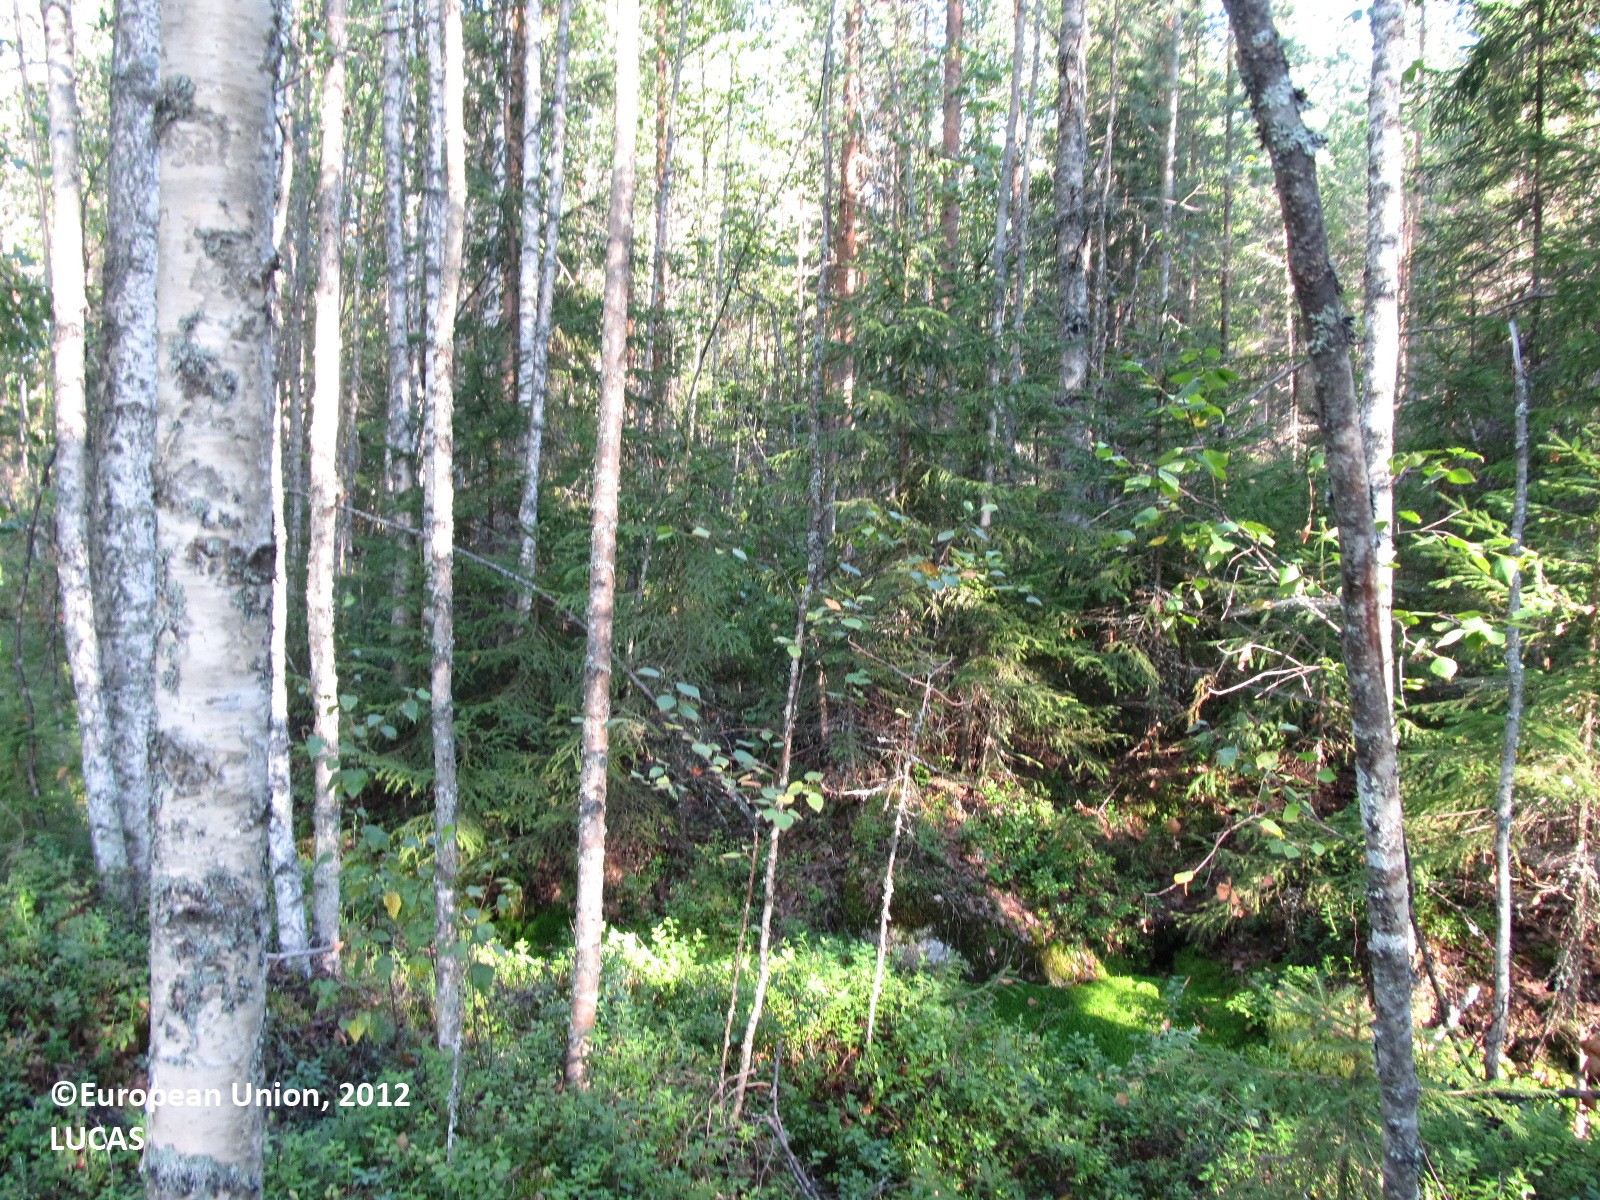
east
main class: Woodland
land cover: Pine dominated mixed woodland
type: boreal forest
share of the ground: 25 - 50 %
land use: Forestry
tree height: > 5 m
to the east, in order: Pine dominated mixed woodland; Ditches and canals; Spruce dominated mixed woodland; Ditches and canals; Grass margins; Paved roads, cycling and walking lanes; Grass margins; Ditches and canals; Spruce dominated coniferous woodland; Ditches and canals; Spruce dominated coniferous woodland; Ditches and canals; Spruce dominated coniferous woodland; Broadleaved woodland
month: August
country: FI
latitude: 62.1410
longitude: 27.5719
